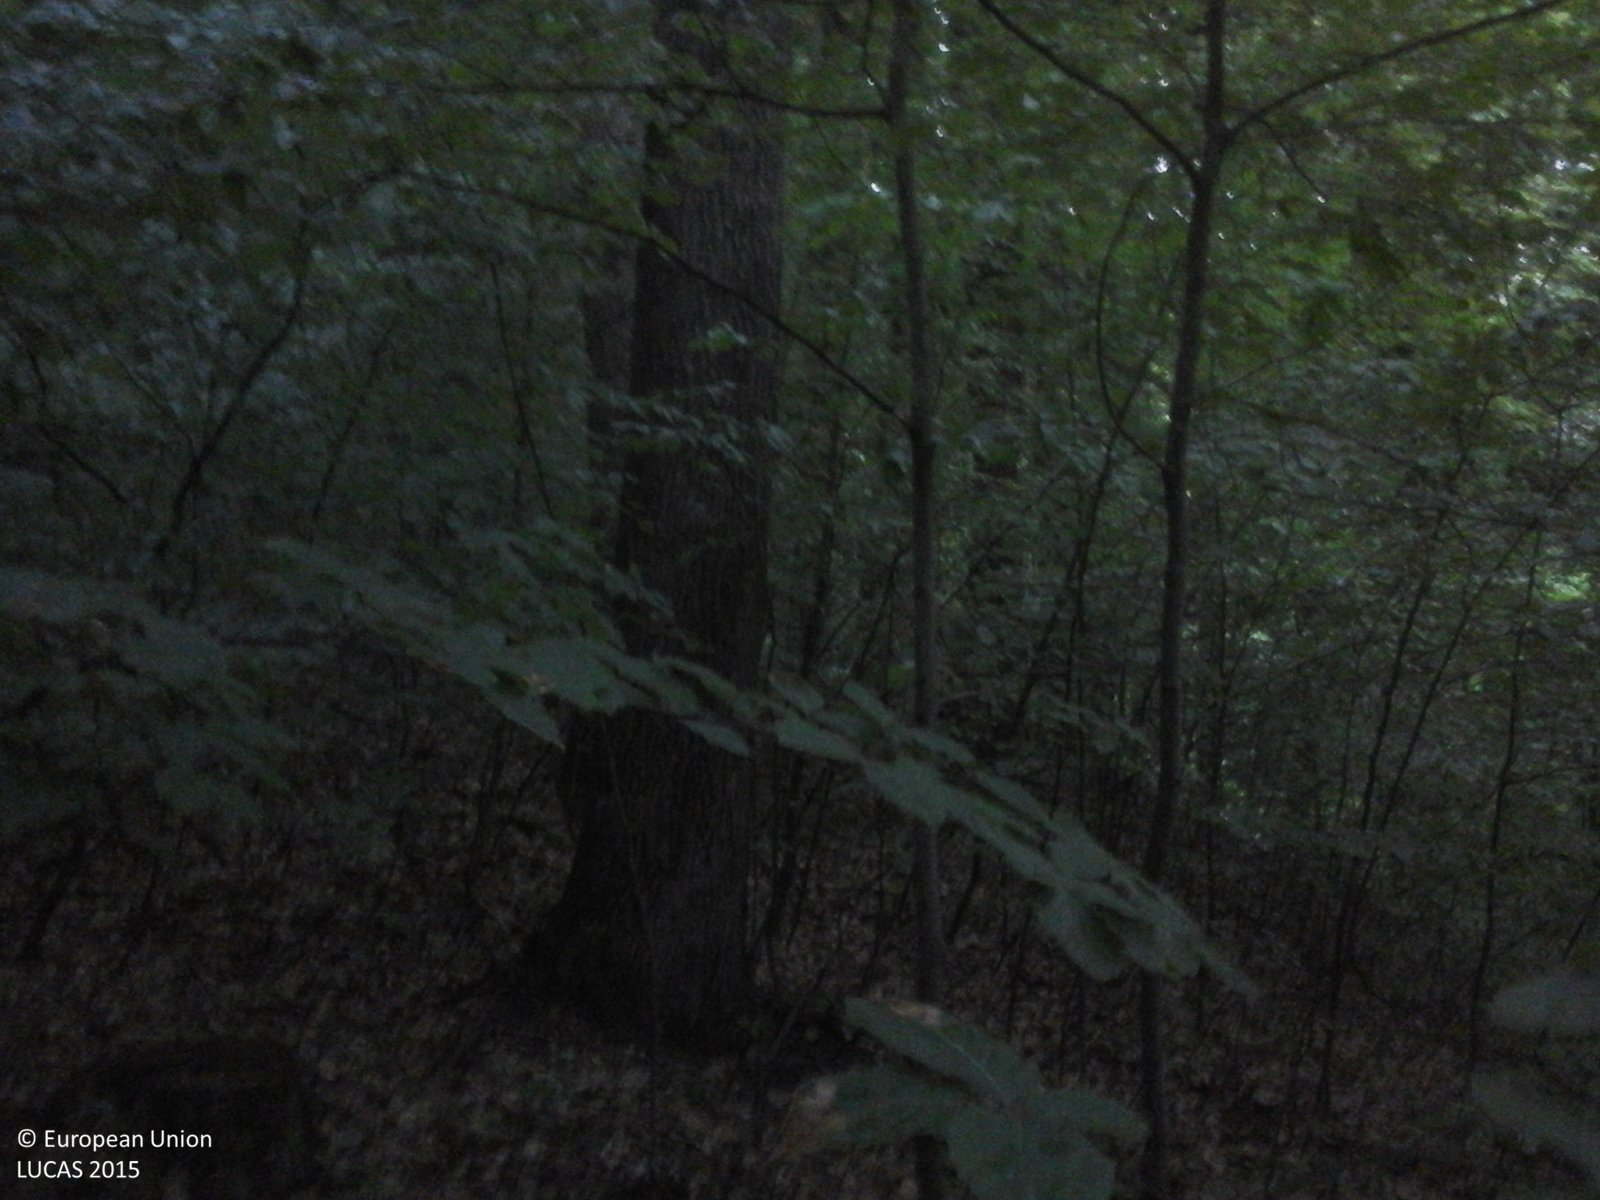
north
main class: Woodland
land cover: Broadleaved woodland
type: beech forest
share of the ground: > 75 %
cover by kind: broadleaved forest trees 100 %
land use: Forestry
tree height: > 5 m
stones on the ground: < 10 %
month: June
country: RO
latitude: 47.2356
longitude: 26.3163
